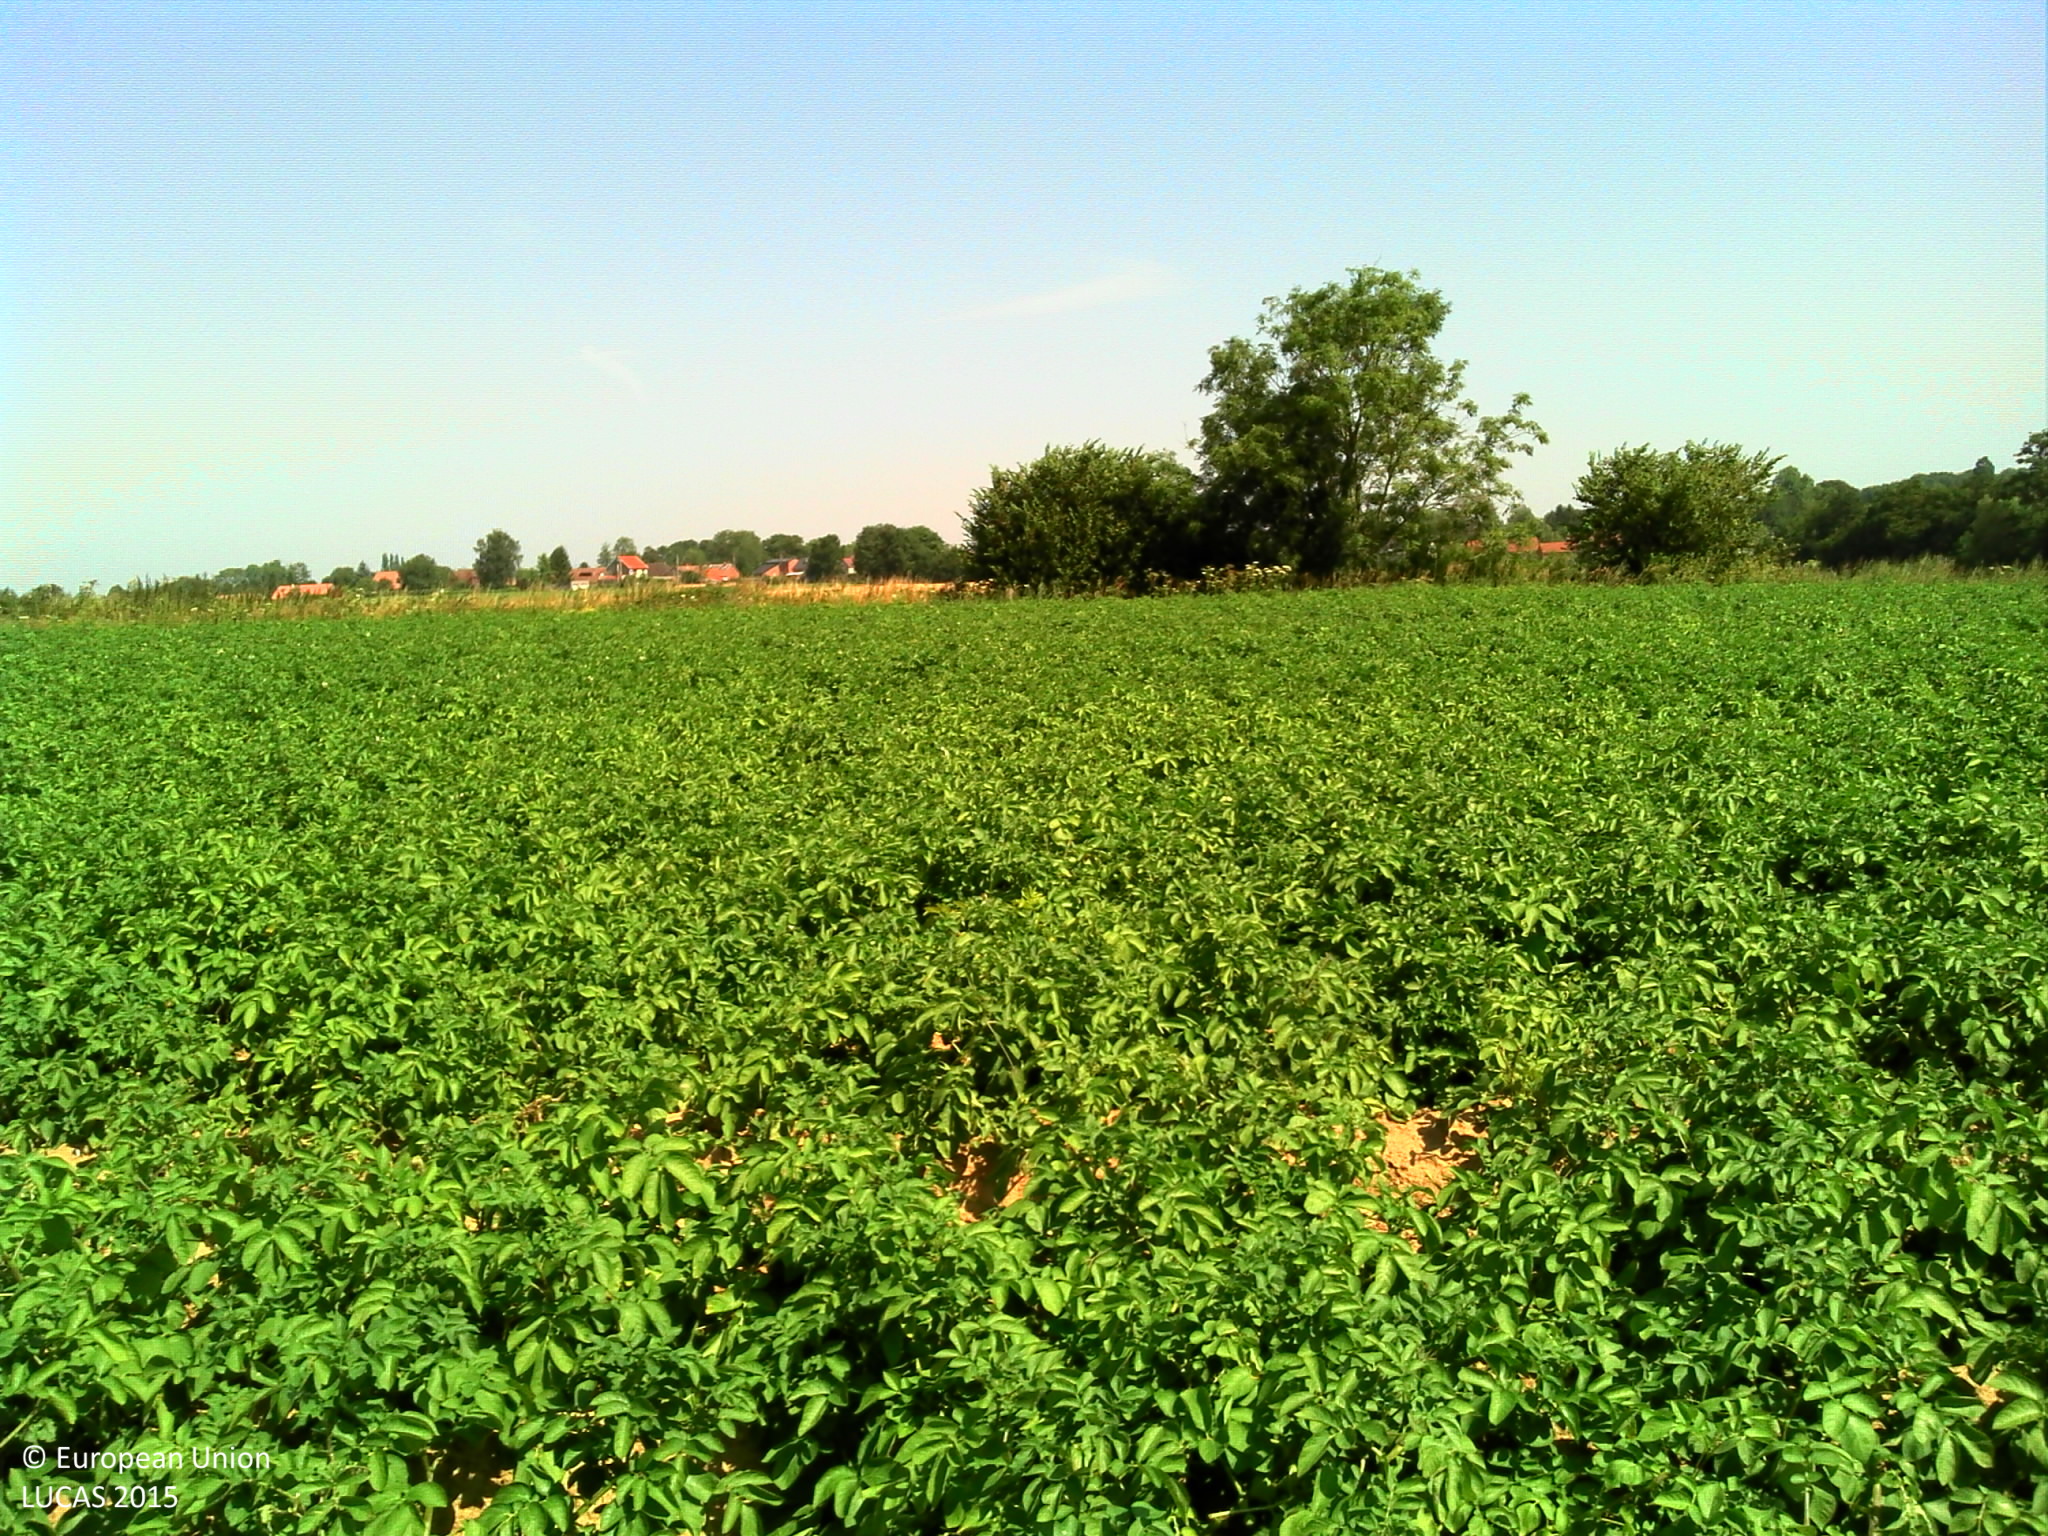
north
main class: Cropland
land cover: Potatoes
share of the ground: > 75 %
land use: Agriculture (excluding fallow land and kitchen gardens)
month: August
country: FR
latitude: 50.3296
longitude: 3.9395
